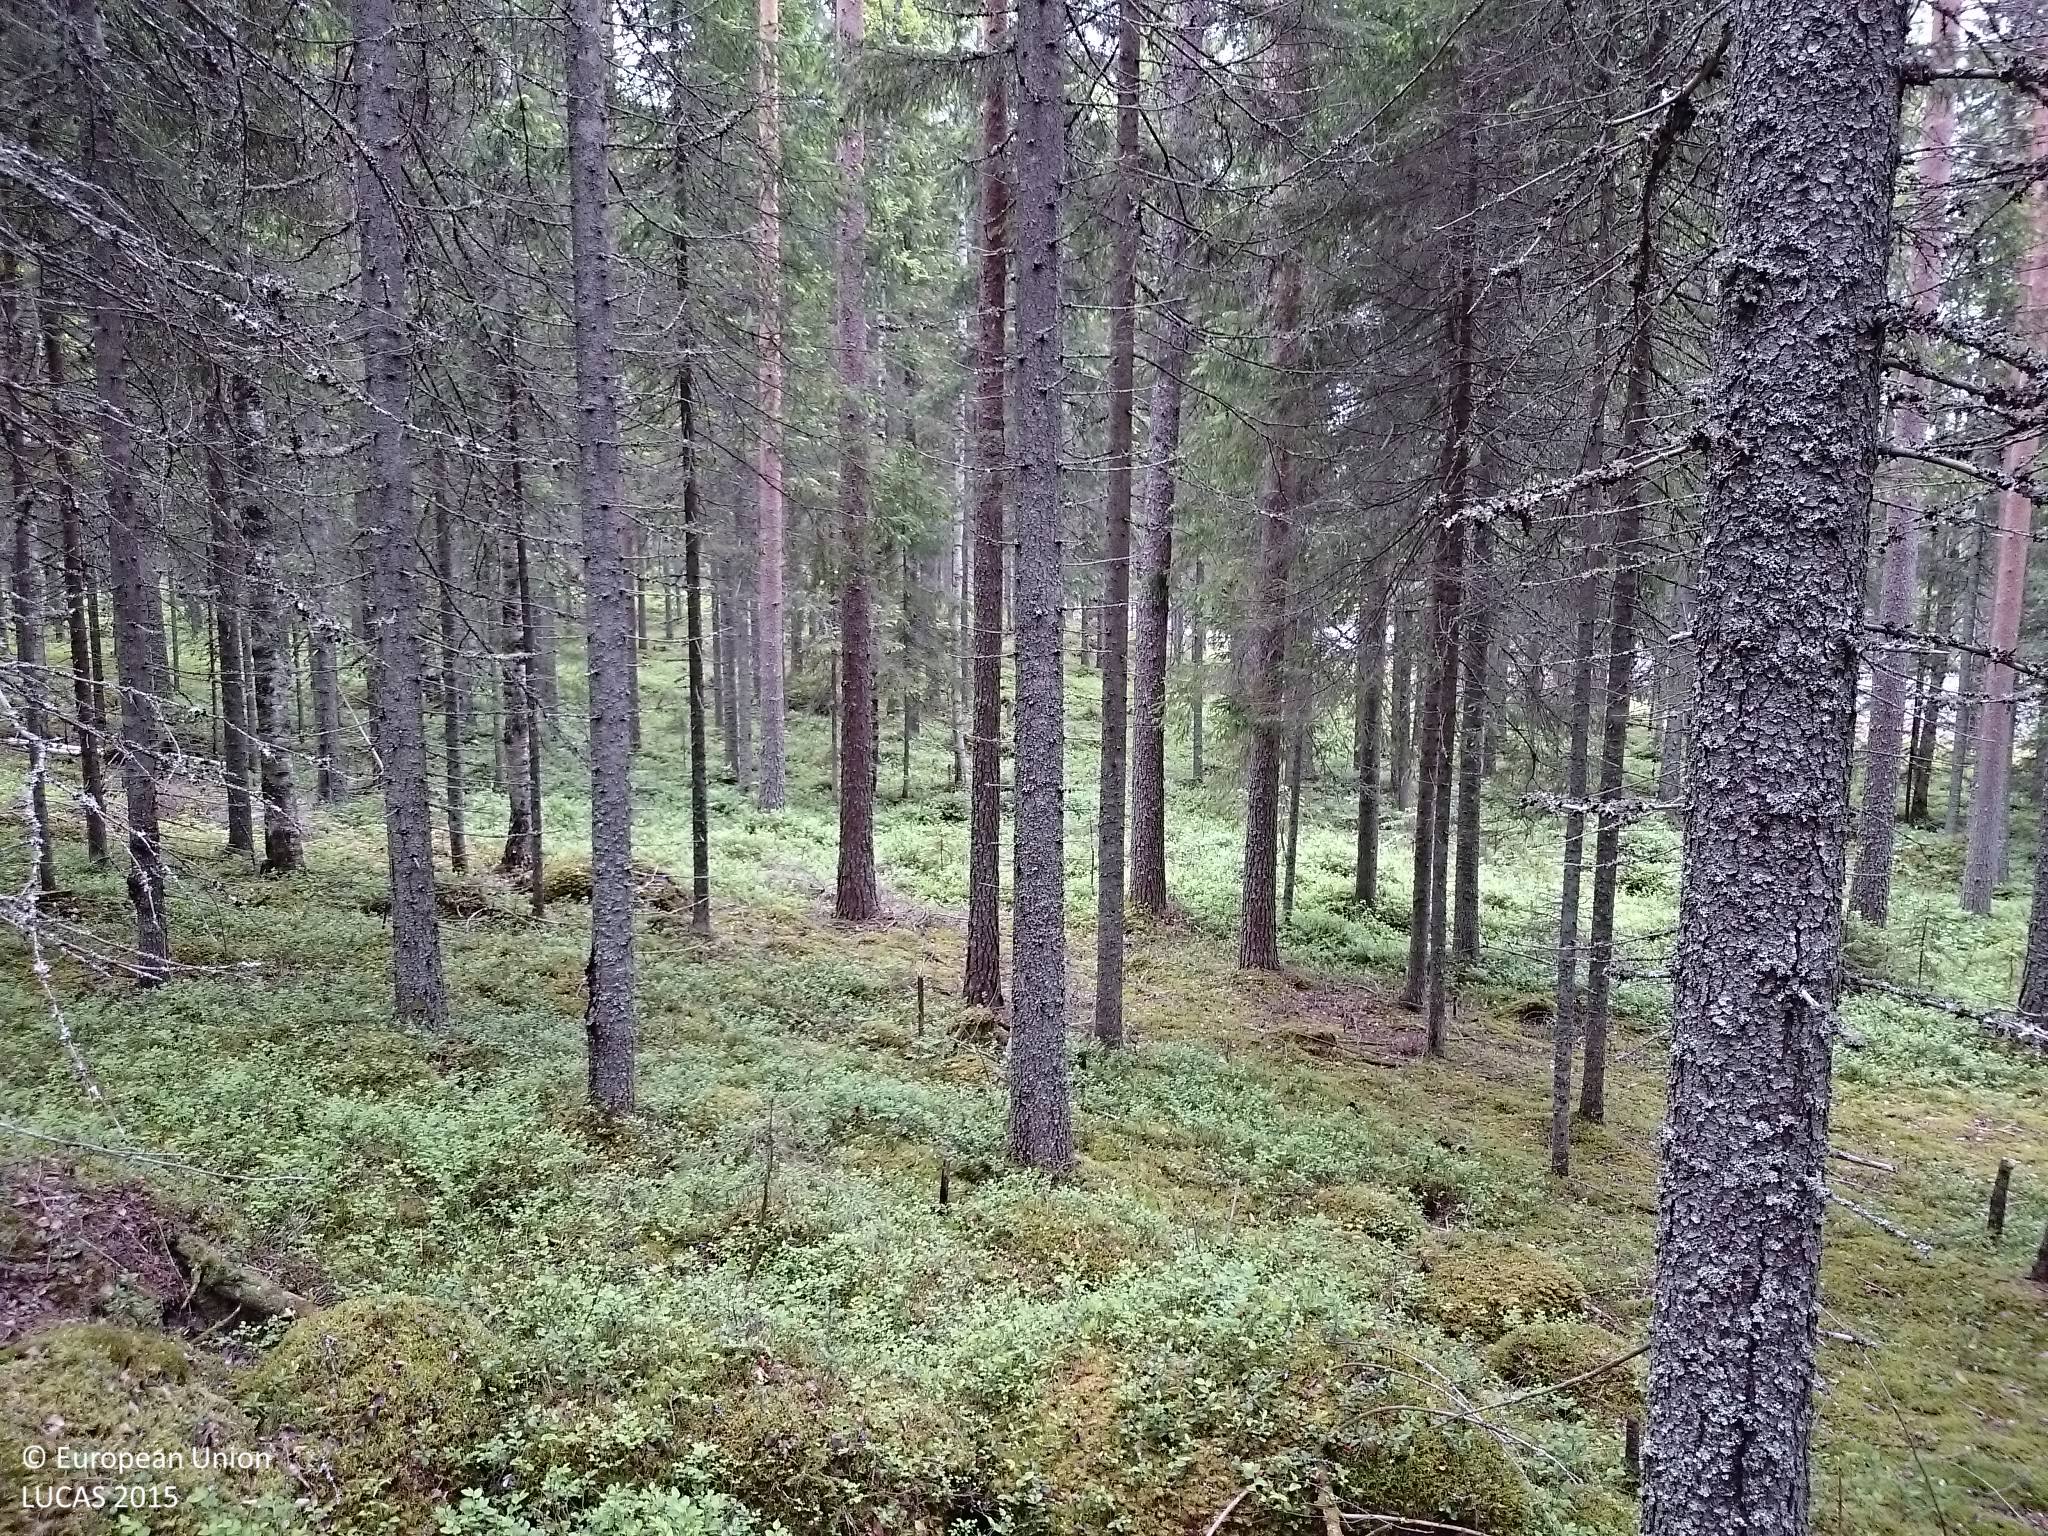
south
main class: Woodland
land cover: Spruce dominated mixed woodland
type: boreal forest
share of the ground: > 75 %
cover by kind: coniferous forest trees 60 %, broadleaved forest trees 20 %, shrubs 15 %, lichens and mosses 5 %
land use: Forestry
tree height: > 5 m
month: June
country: SE
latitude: 64.1308
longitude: 20.6430
